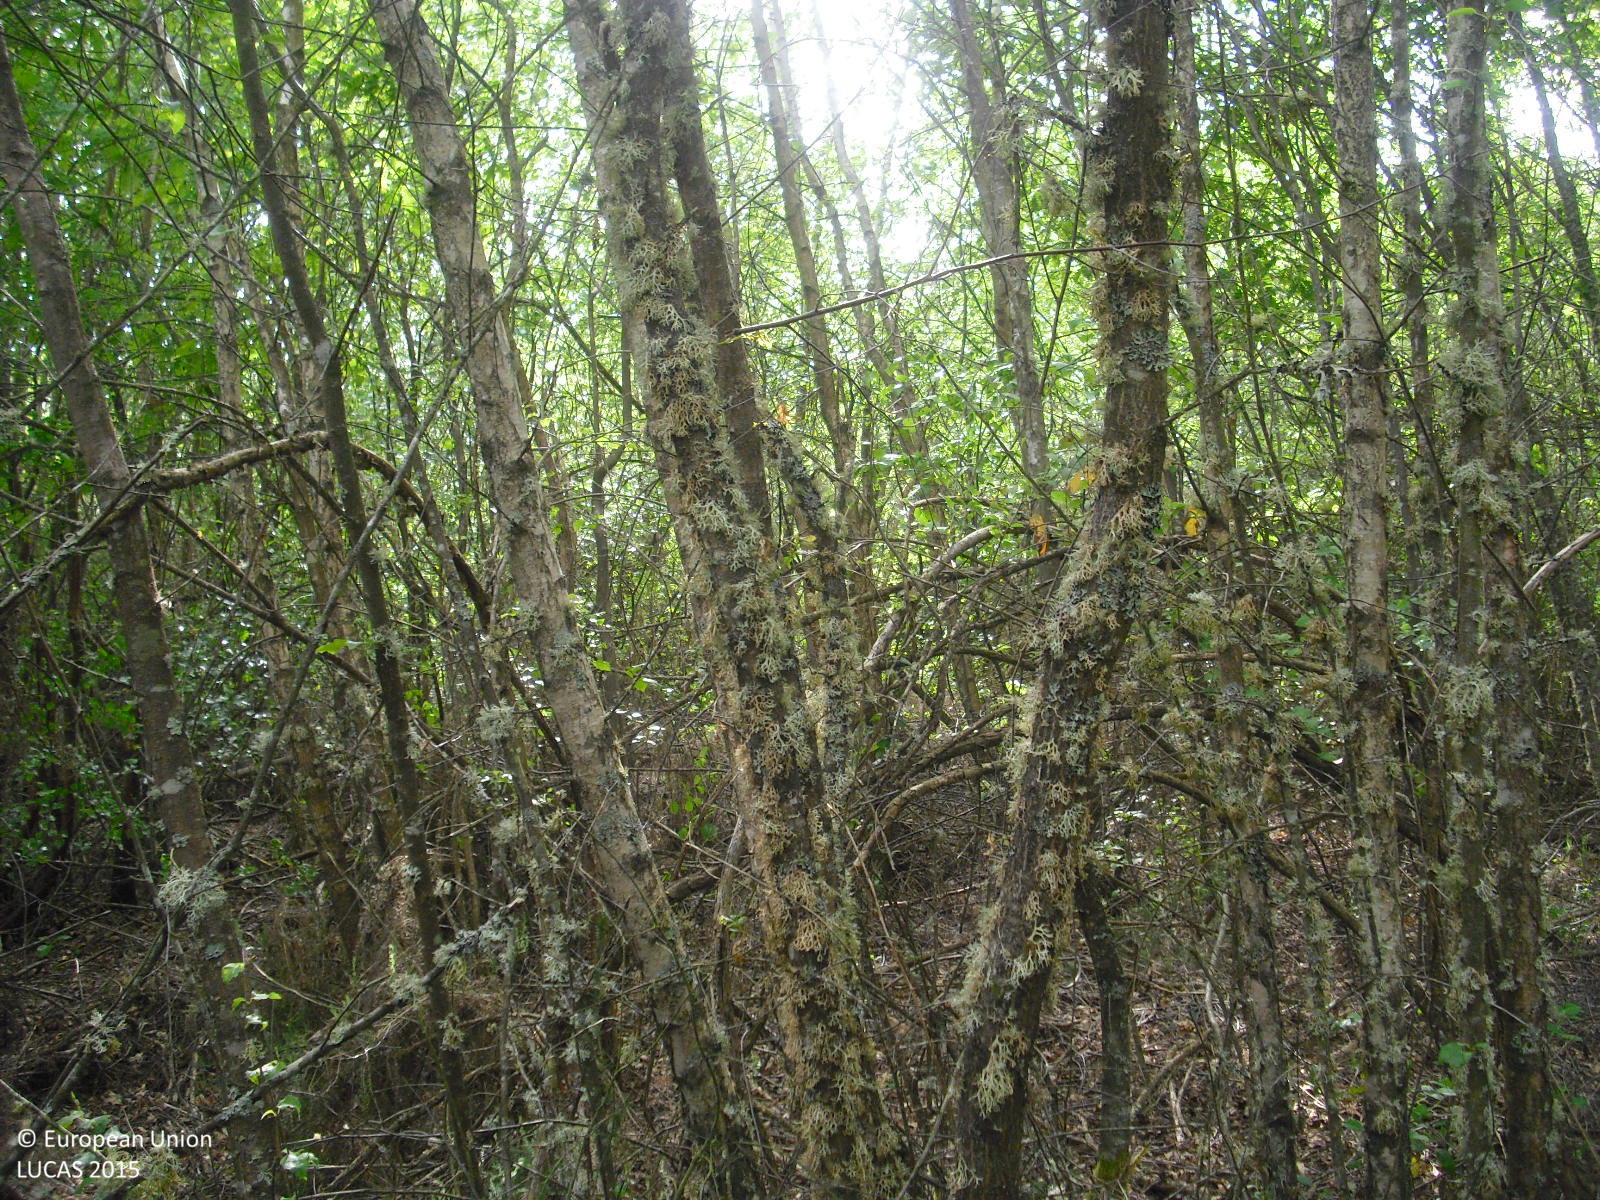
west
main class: Woodland
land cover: Broadleaved woodland
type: acidophilous oak and oak-birch forest
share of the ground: > 75 %
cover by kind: broadleaved forest trees 80 %, shrubs 20 %
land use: Semi-natural and natural areas not in use
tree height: > 5 m
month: May
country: ES
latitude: 42.1717
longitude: -7.6831
